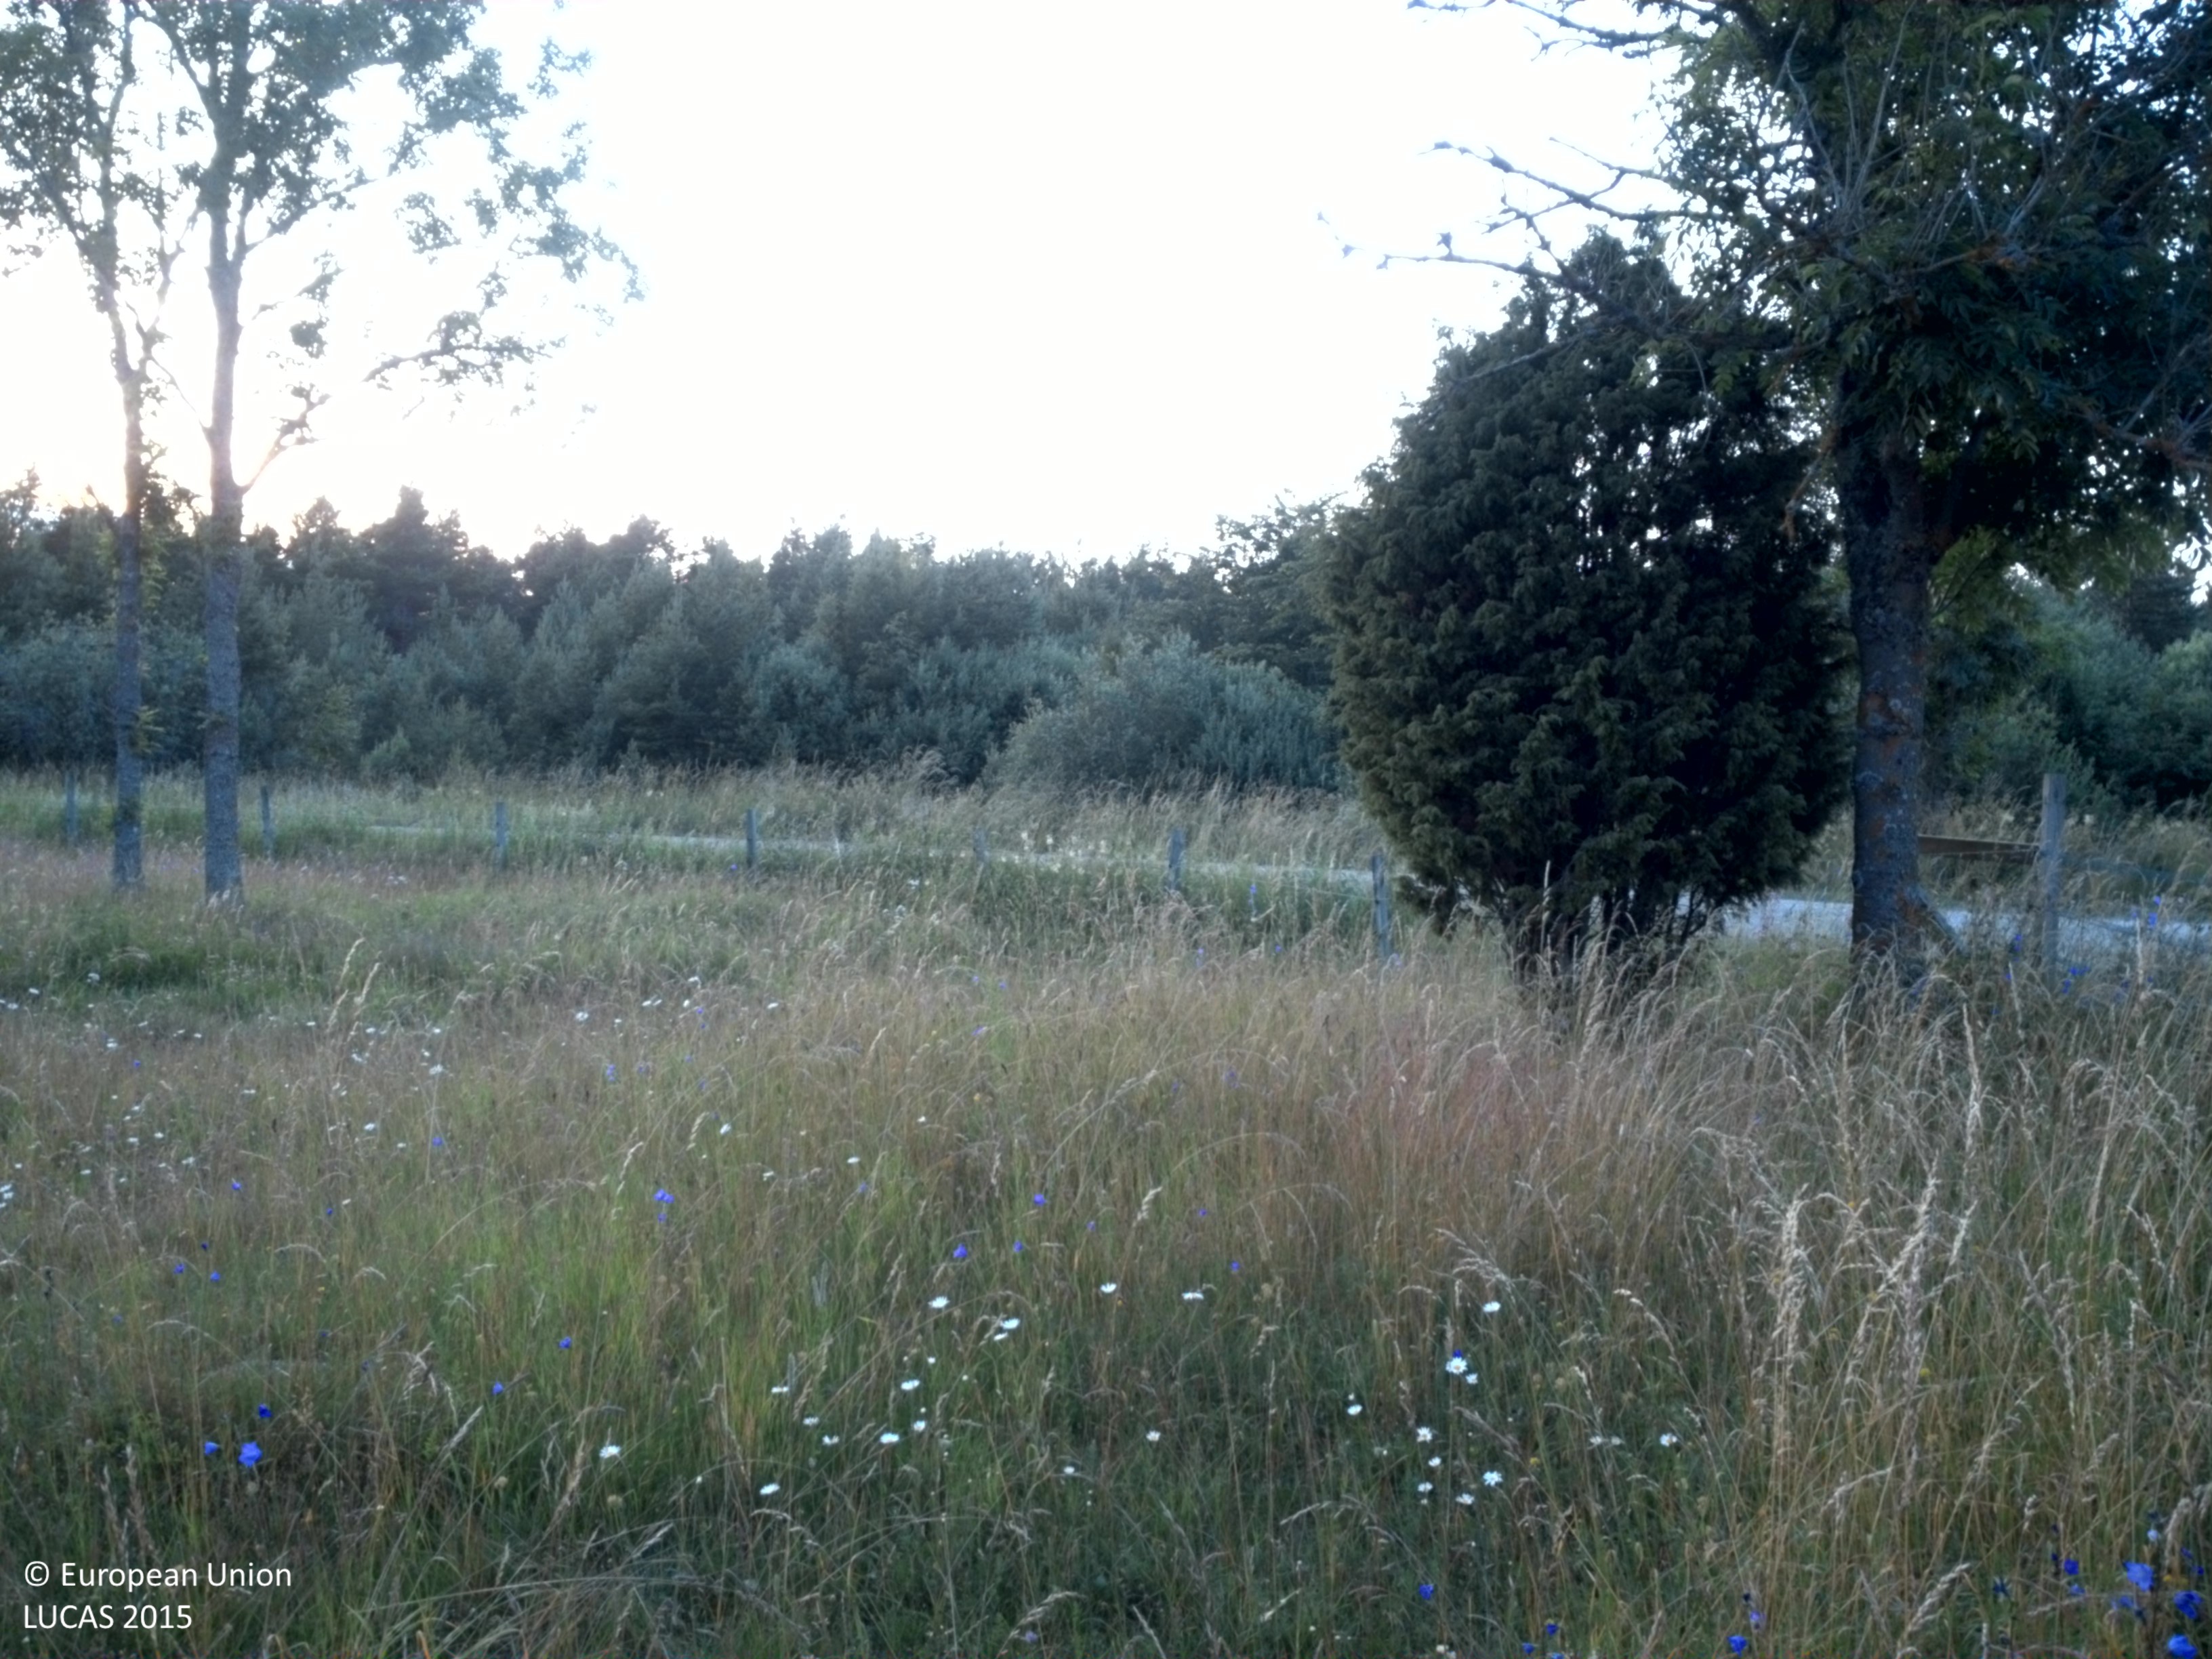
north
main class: Grassland
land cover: Grassland with sparse tree/shrub cover
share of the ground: > 75 %
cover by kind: herbaceous plants 95 %, broadleaved forest trees 5 %
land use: Agriculture (excluding fallow land and kitchen gardens)
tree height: > 5 m
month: July
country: SE
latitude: 57.6471
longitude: 18.7052
